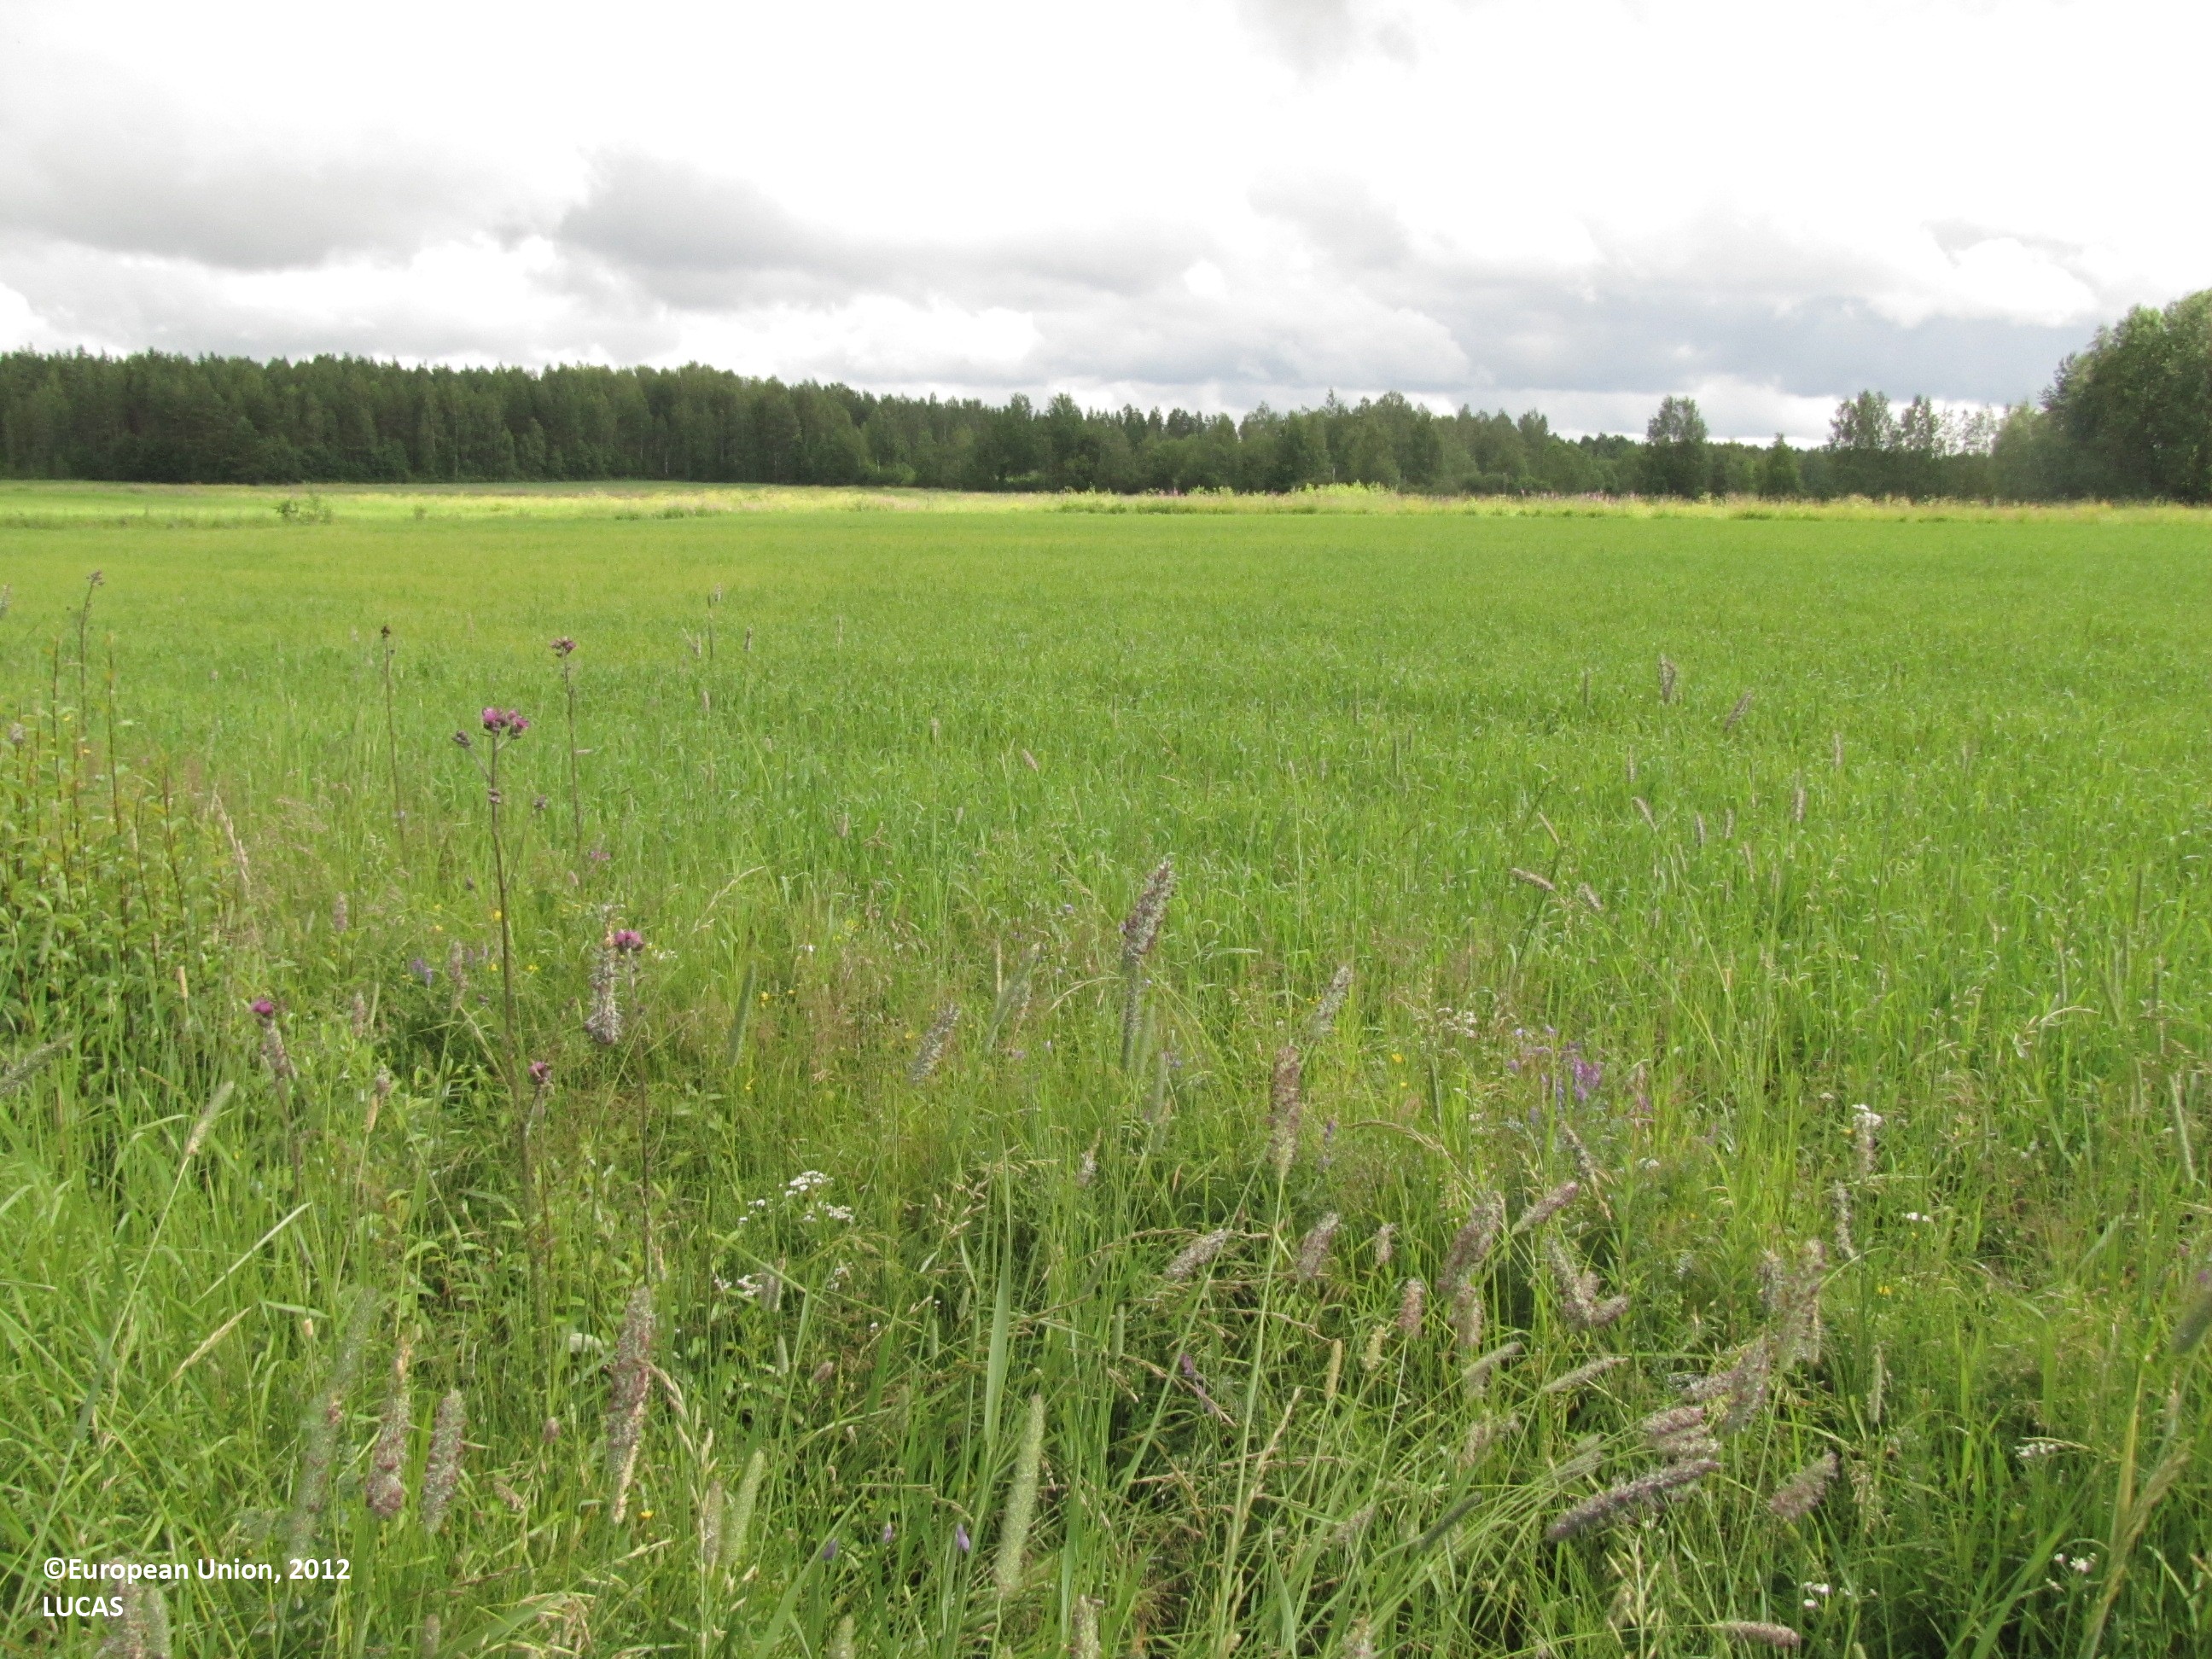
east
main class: Cropland
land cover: Oats
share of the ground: 50 - 75 %
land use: Agriculture (excluding fallow land and kitchen gardens)
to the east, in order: Oats; Grass margins; Ditches and canals; Grass margins; Oats; Grass margins; Ditches and canals; Grass margins; Temporary grasslands; Grass margins; Ditches and canals; Grass margins; Tracks; Grass margins; Oats; Grass margins; Ditches and canals; Grass margins; Oats; Grass margins; Ditches and canals; Grass margins; Oats
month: July
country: FI
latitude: 62.3103
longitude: 23.3221
